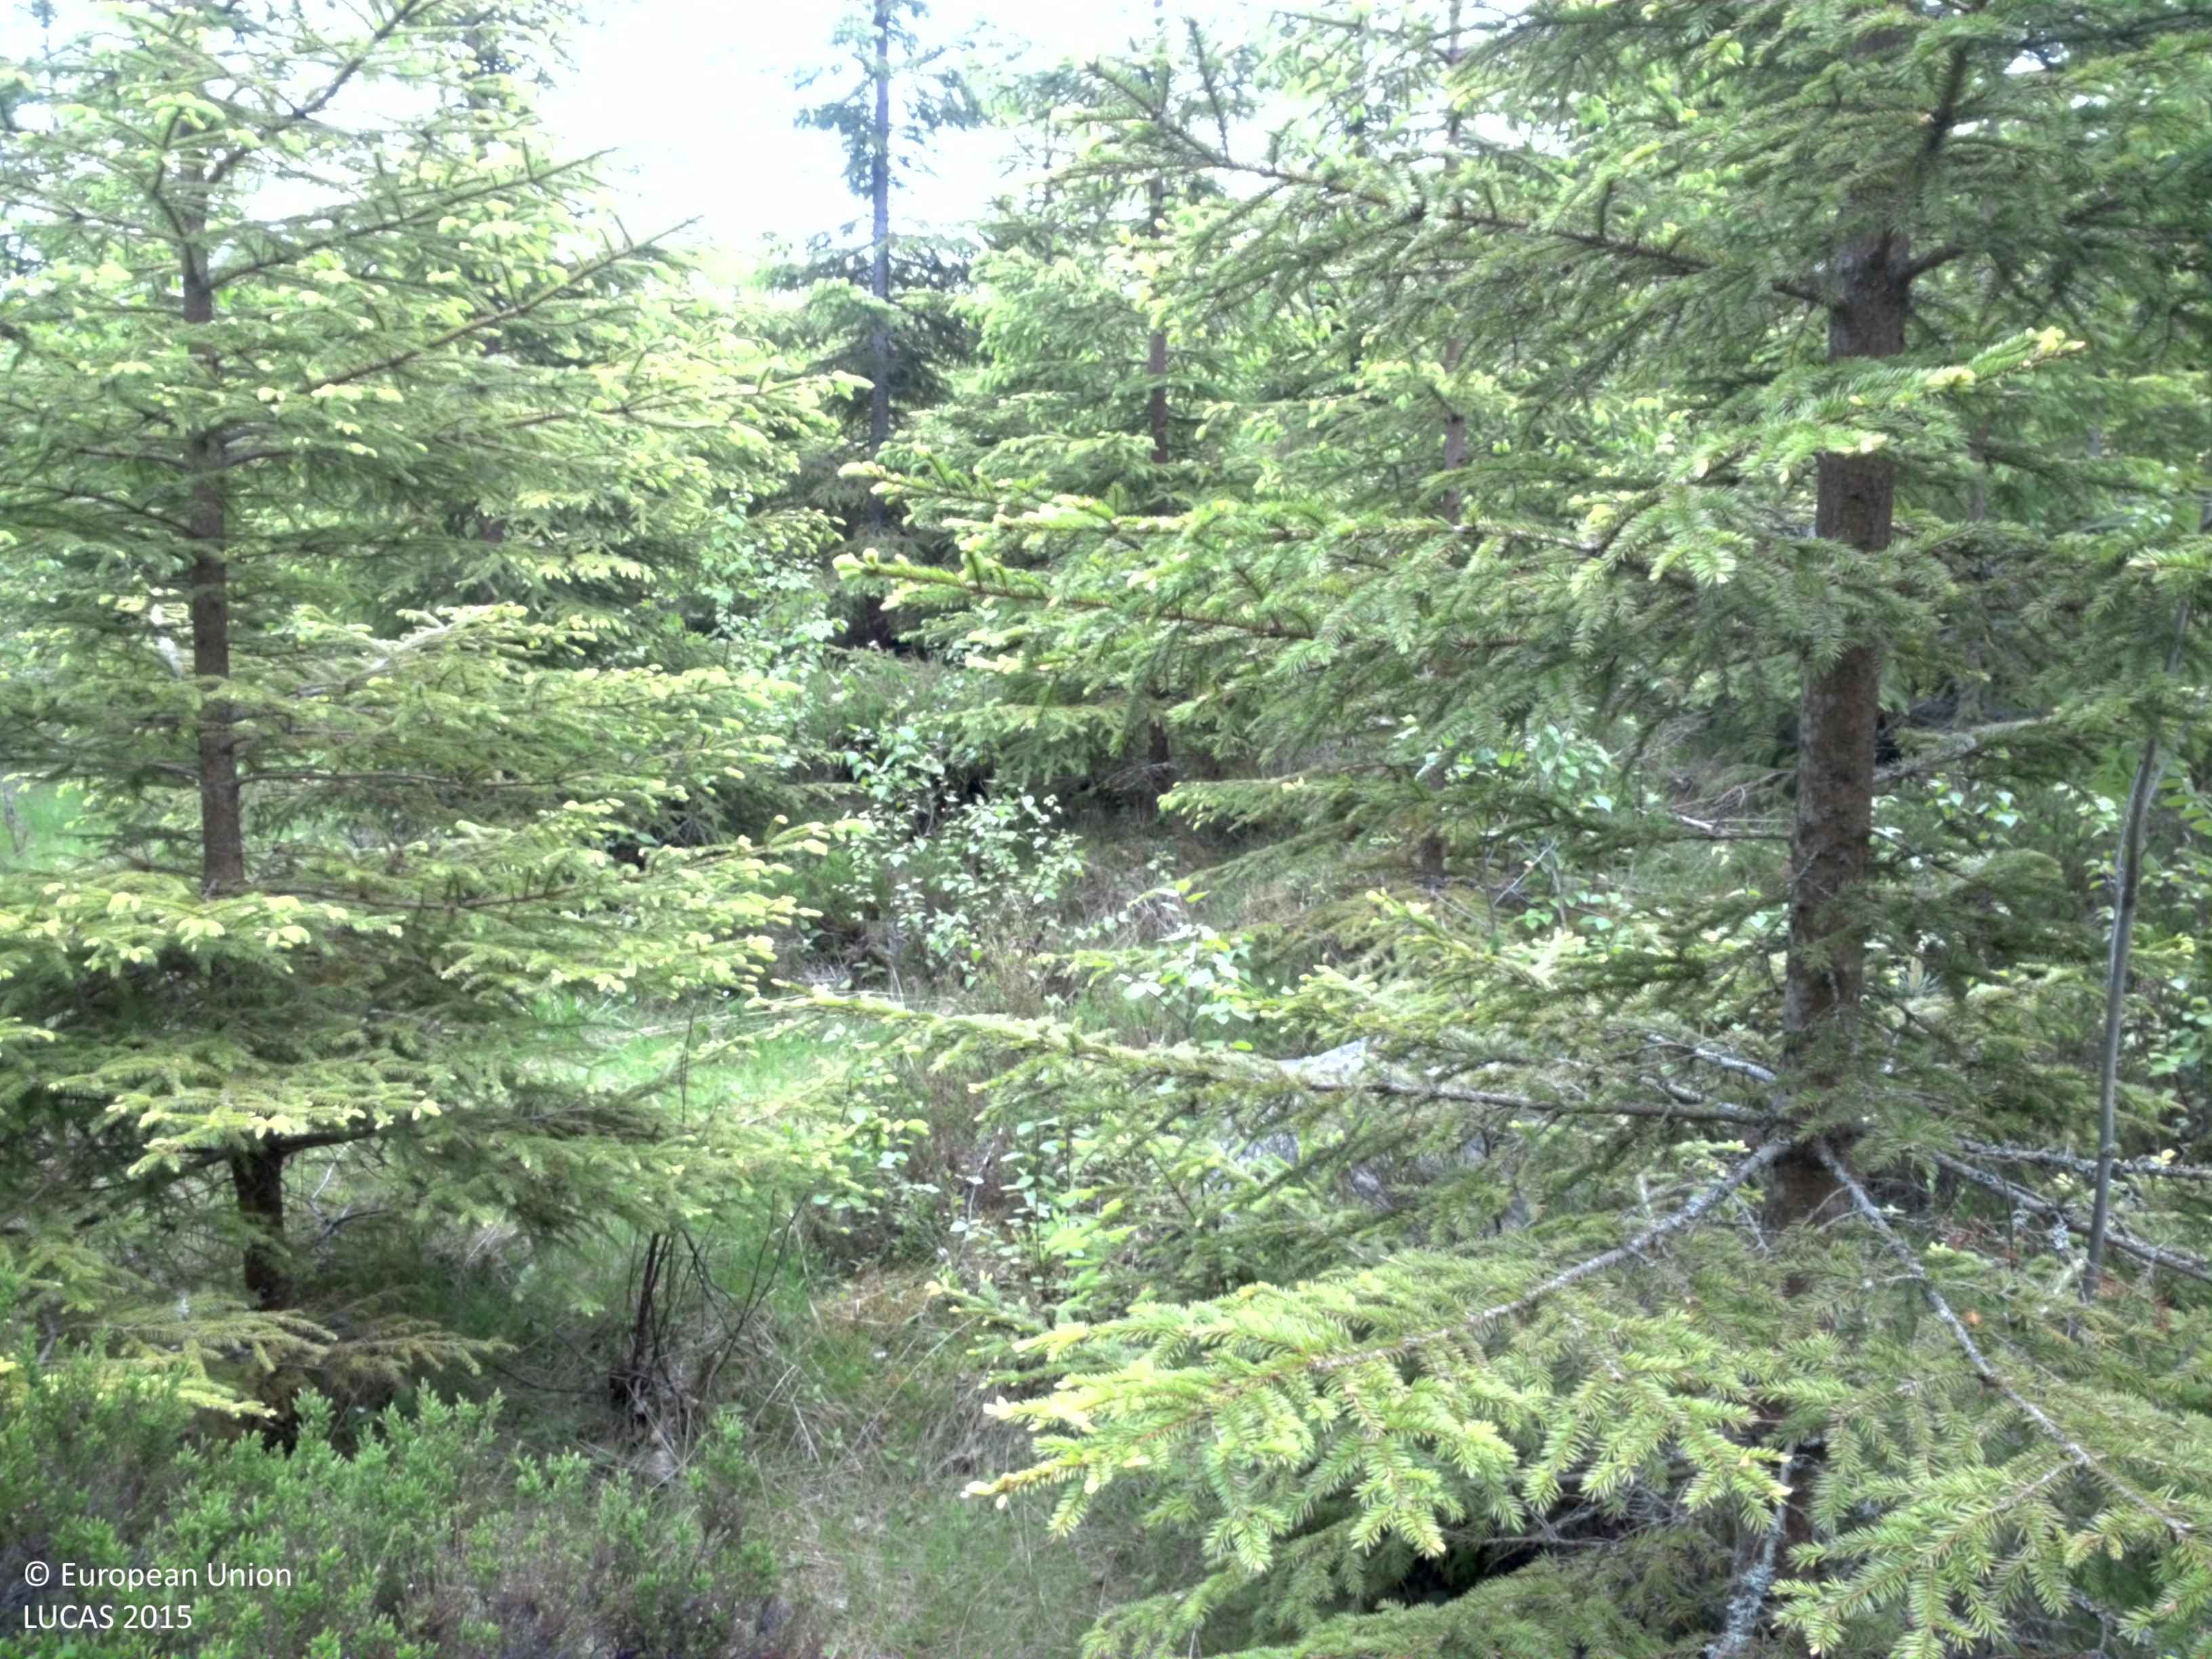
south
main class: Woodland
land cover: Spruce dominated mixed woodland
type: boreal forest
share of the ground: 50 - 75 %
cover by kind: coniferous forest trees 40 %, broadleaved forest trees 30 %, shrubs 15 %, herbaceous plants 10 %, lichens and mosses 5 %
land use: Forestry
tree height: < 5 m
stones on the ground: < 10 %
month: June
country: SE
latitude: 59.5892
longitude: 14.4008
